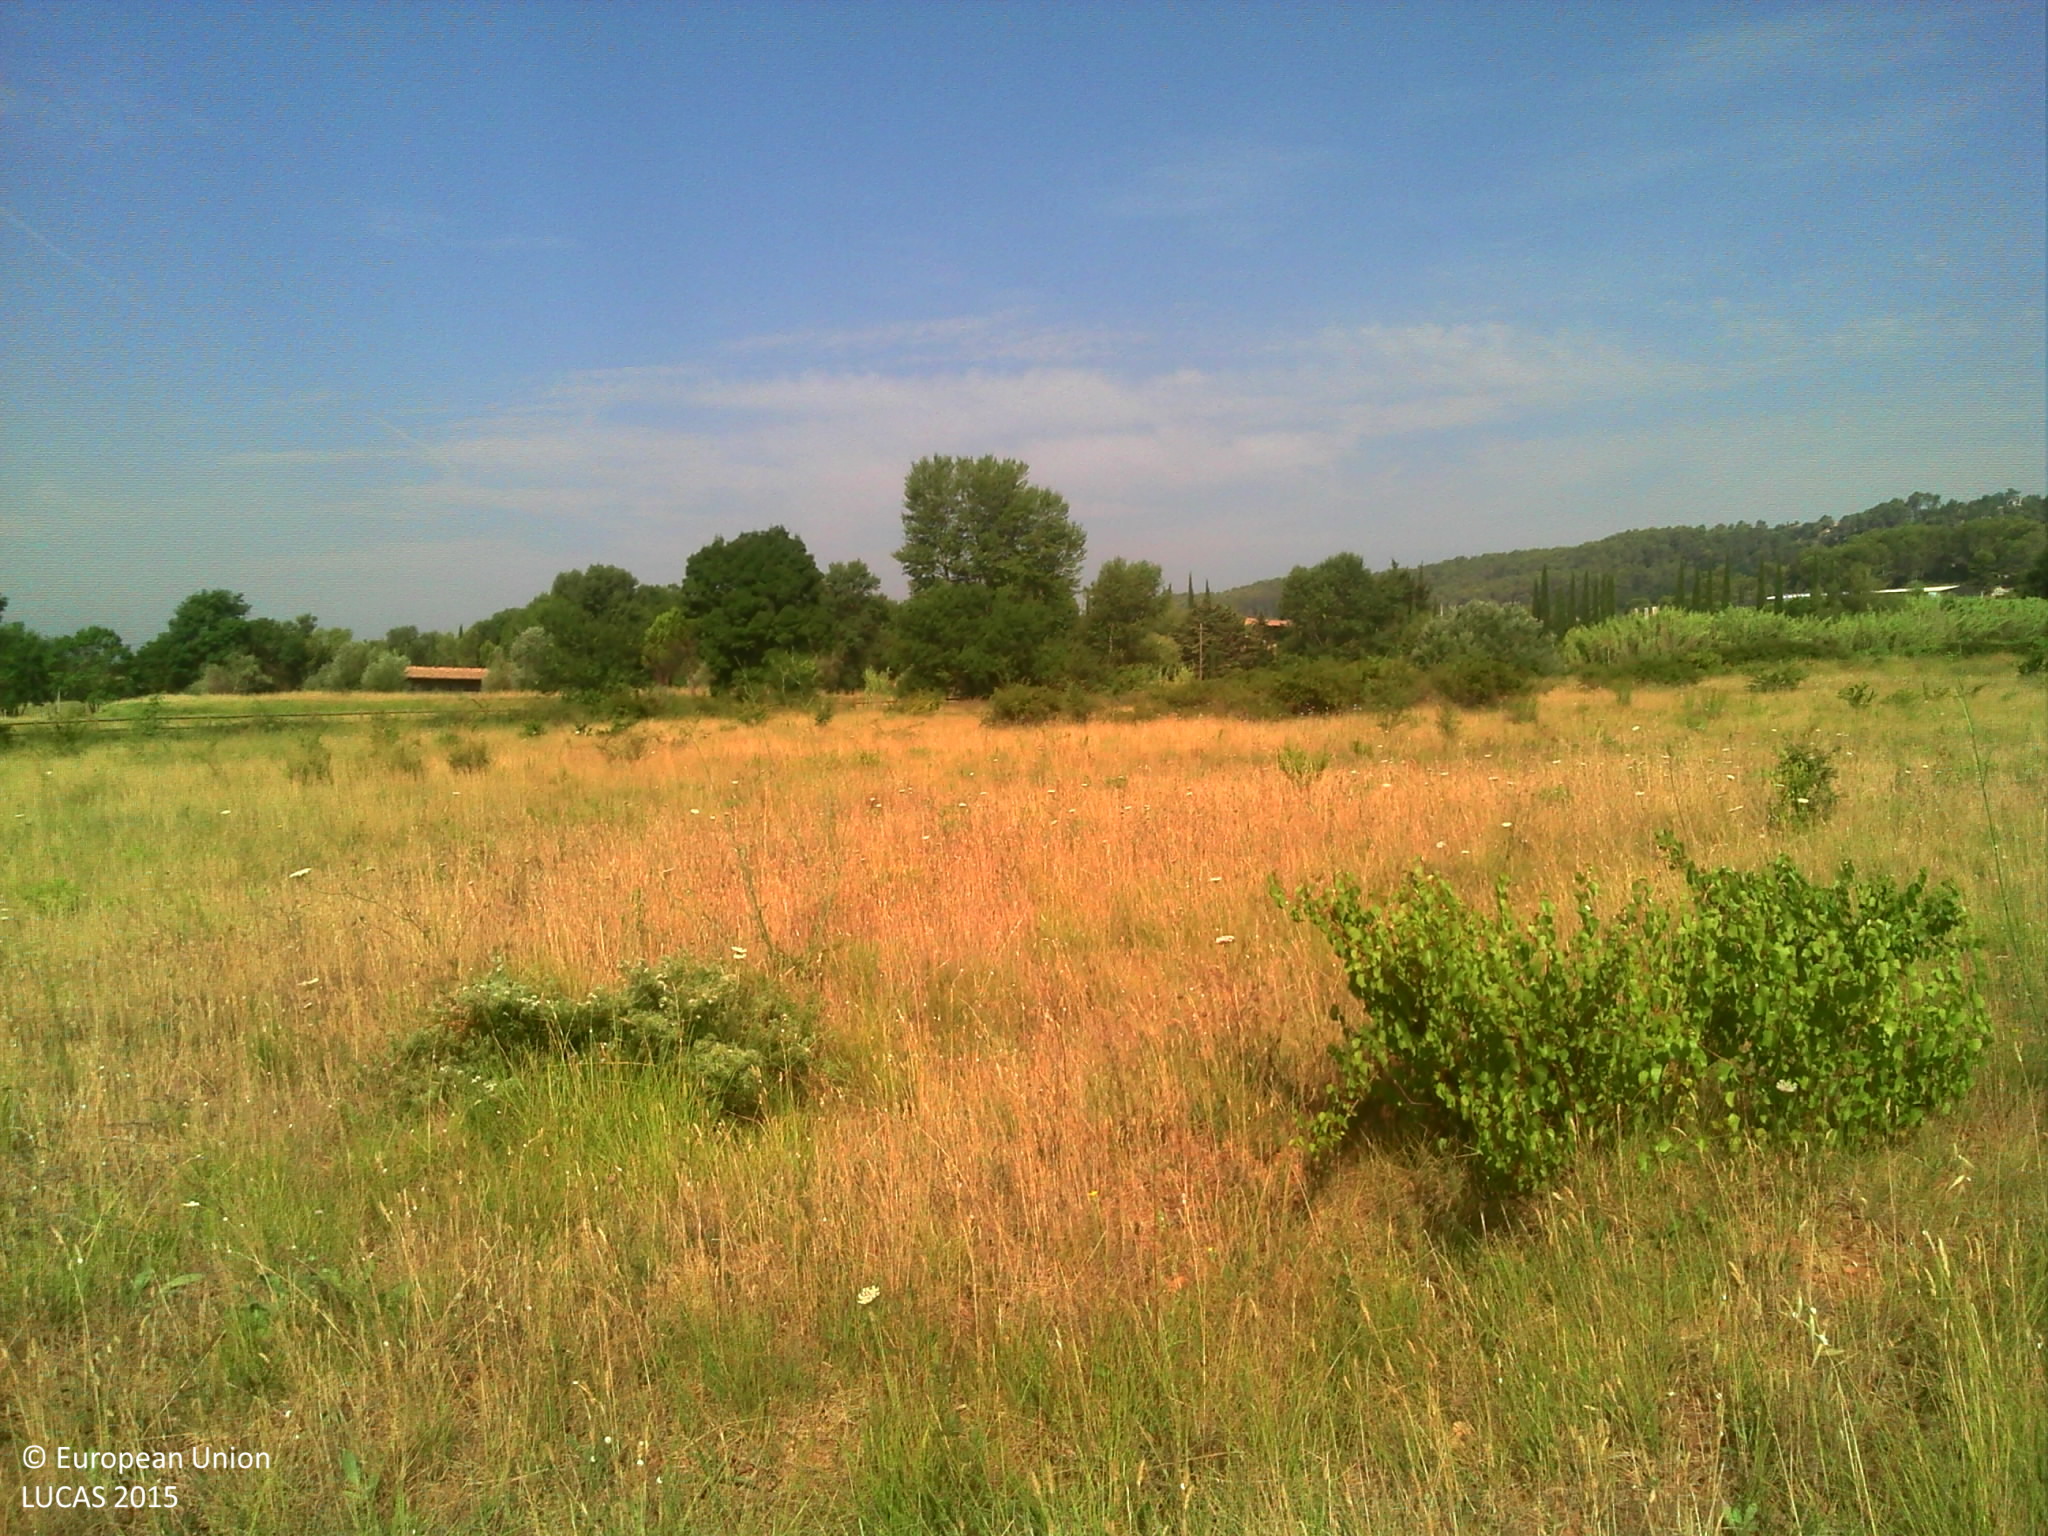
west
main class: Cropland
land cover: Vineyards
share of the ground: 25 - 50 %
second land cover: Grassland without tree/shrub cover
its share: > 75 %
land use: Abandoned areas
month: July
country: FR
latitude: 43.4038
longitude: 6.4156
